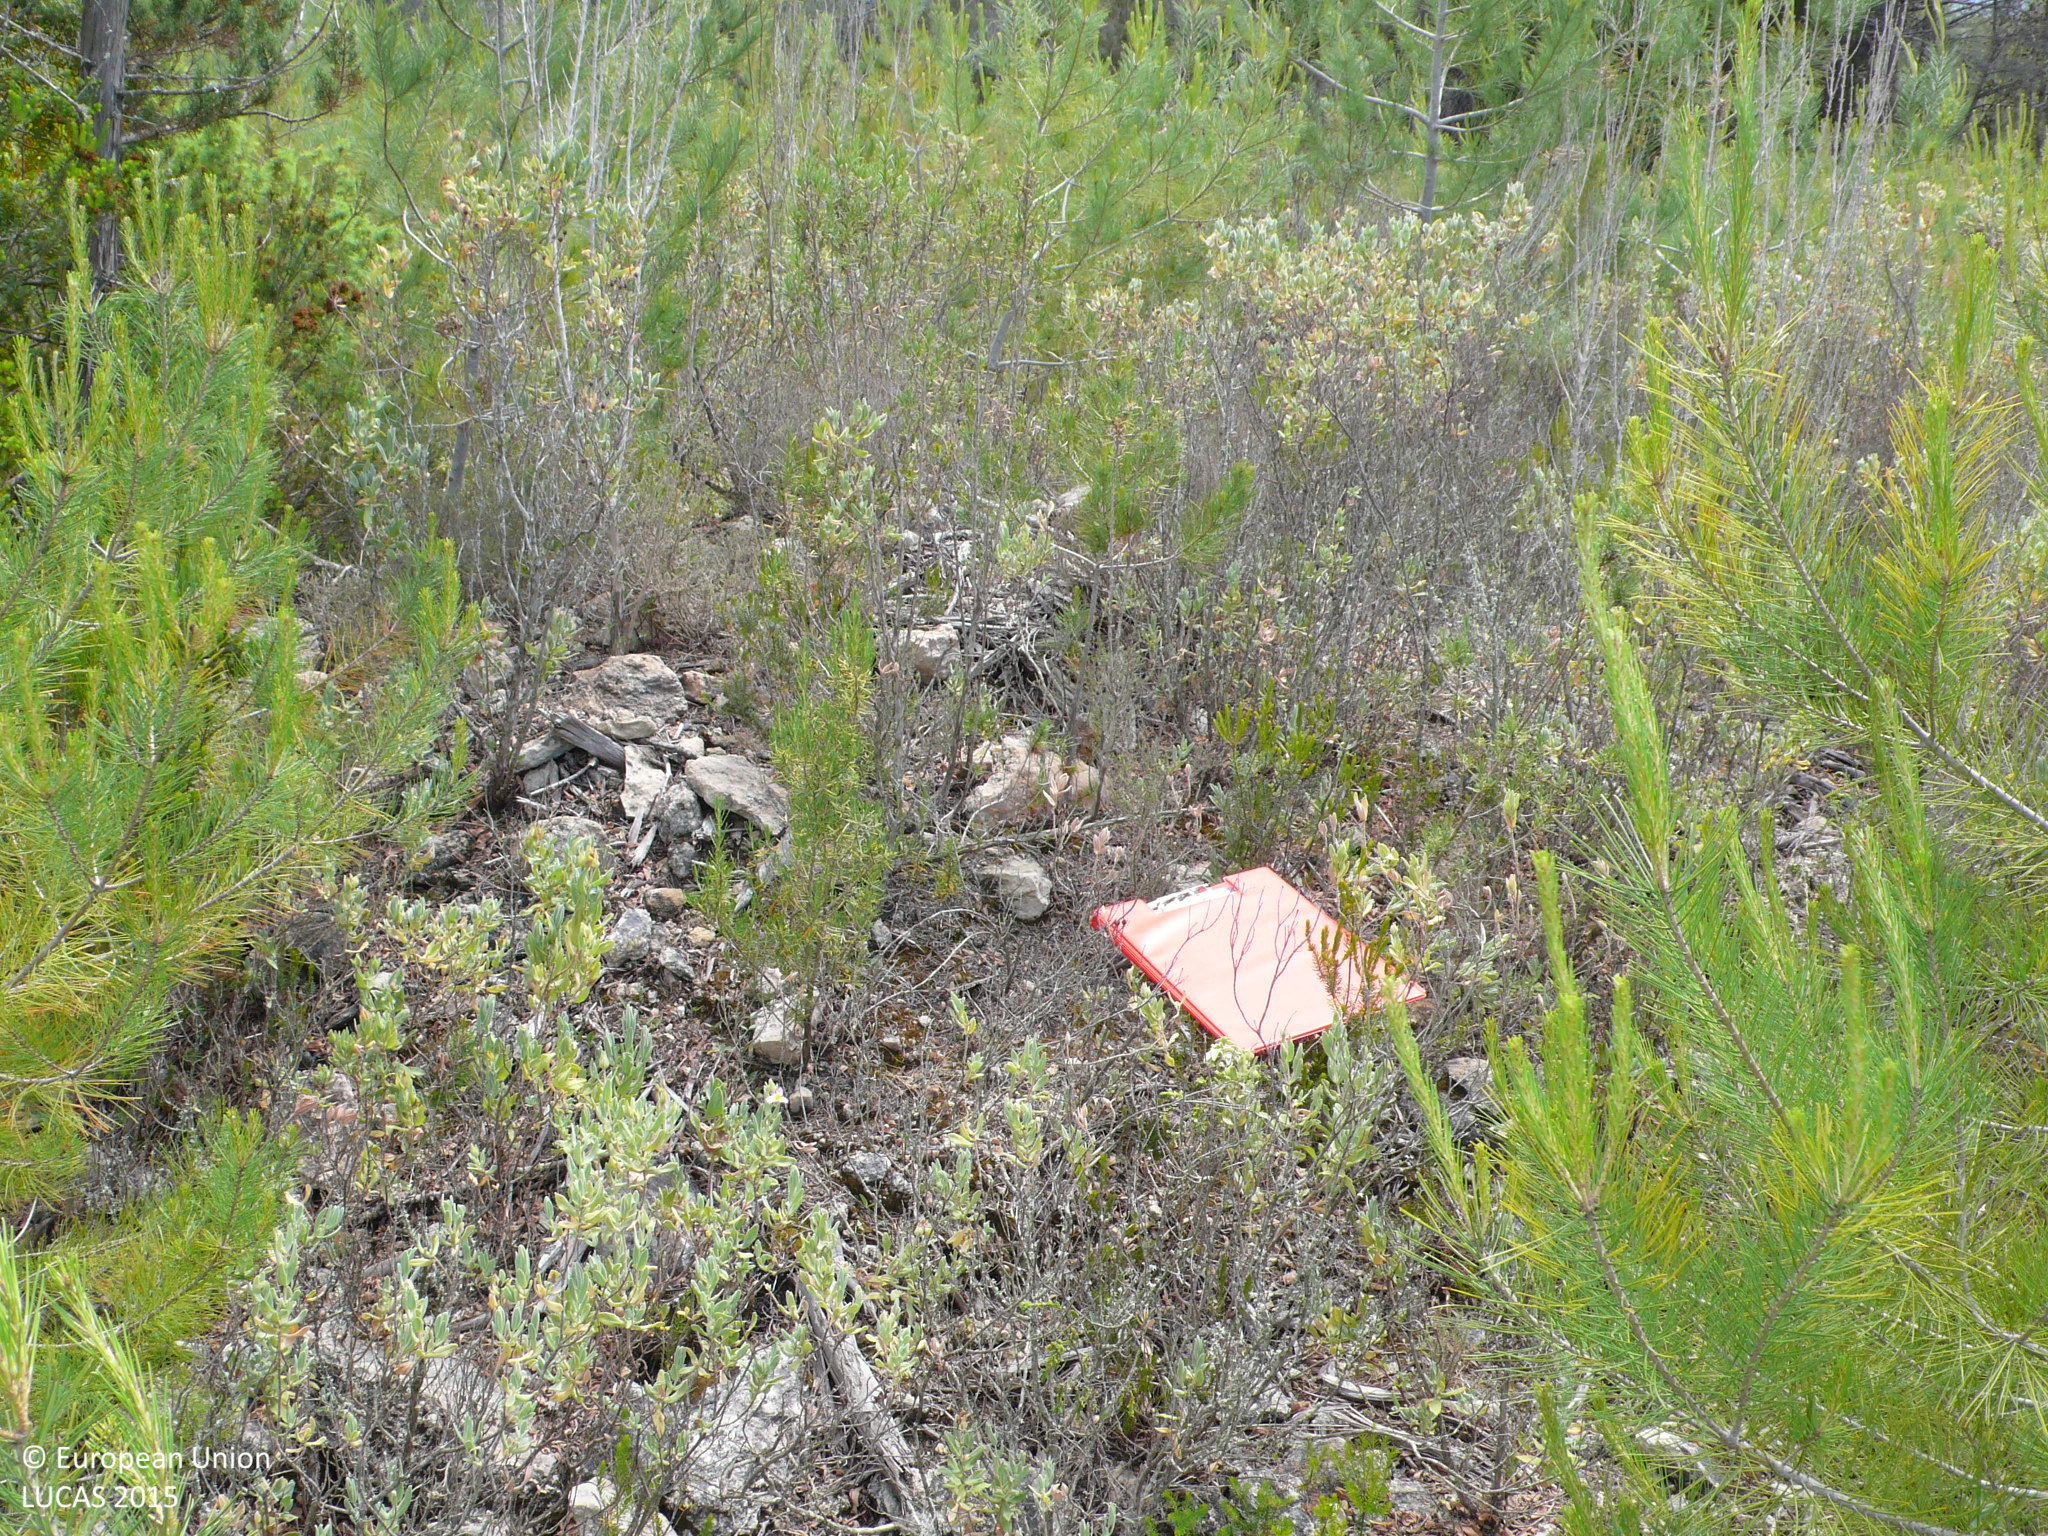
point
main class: Woodland
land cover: Pine dominated coniferous woodland
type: coniferous forest of the mediterranean region
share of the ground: 25 - 50 %
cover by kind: shrubs 60 %, coniferous forest trees 40 %
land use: Forestry
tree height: < 5 m
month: May
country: ES
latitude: 39.0763
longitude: 1.4691
